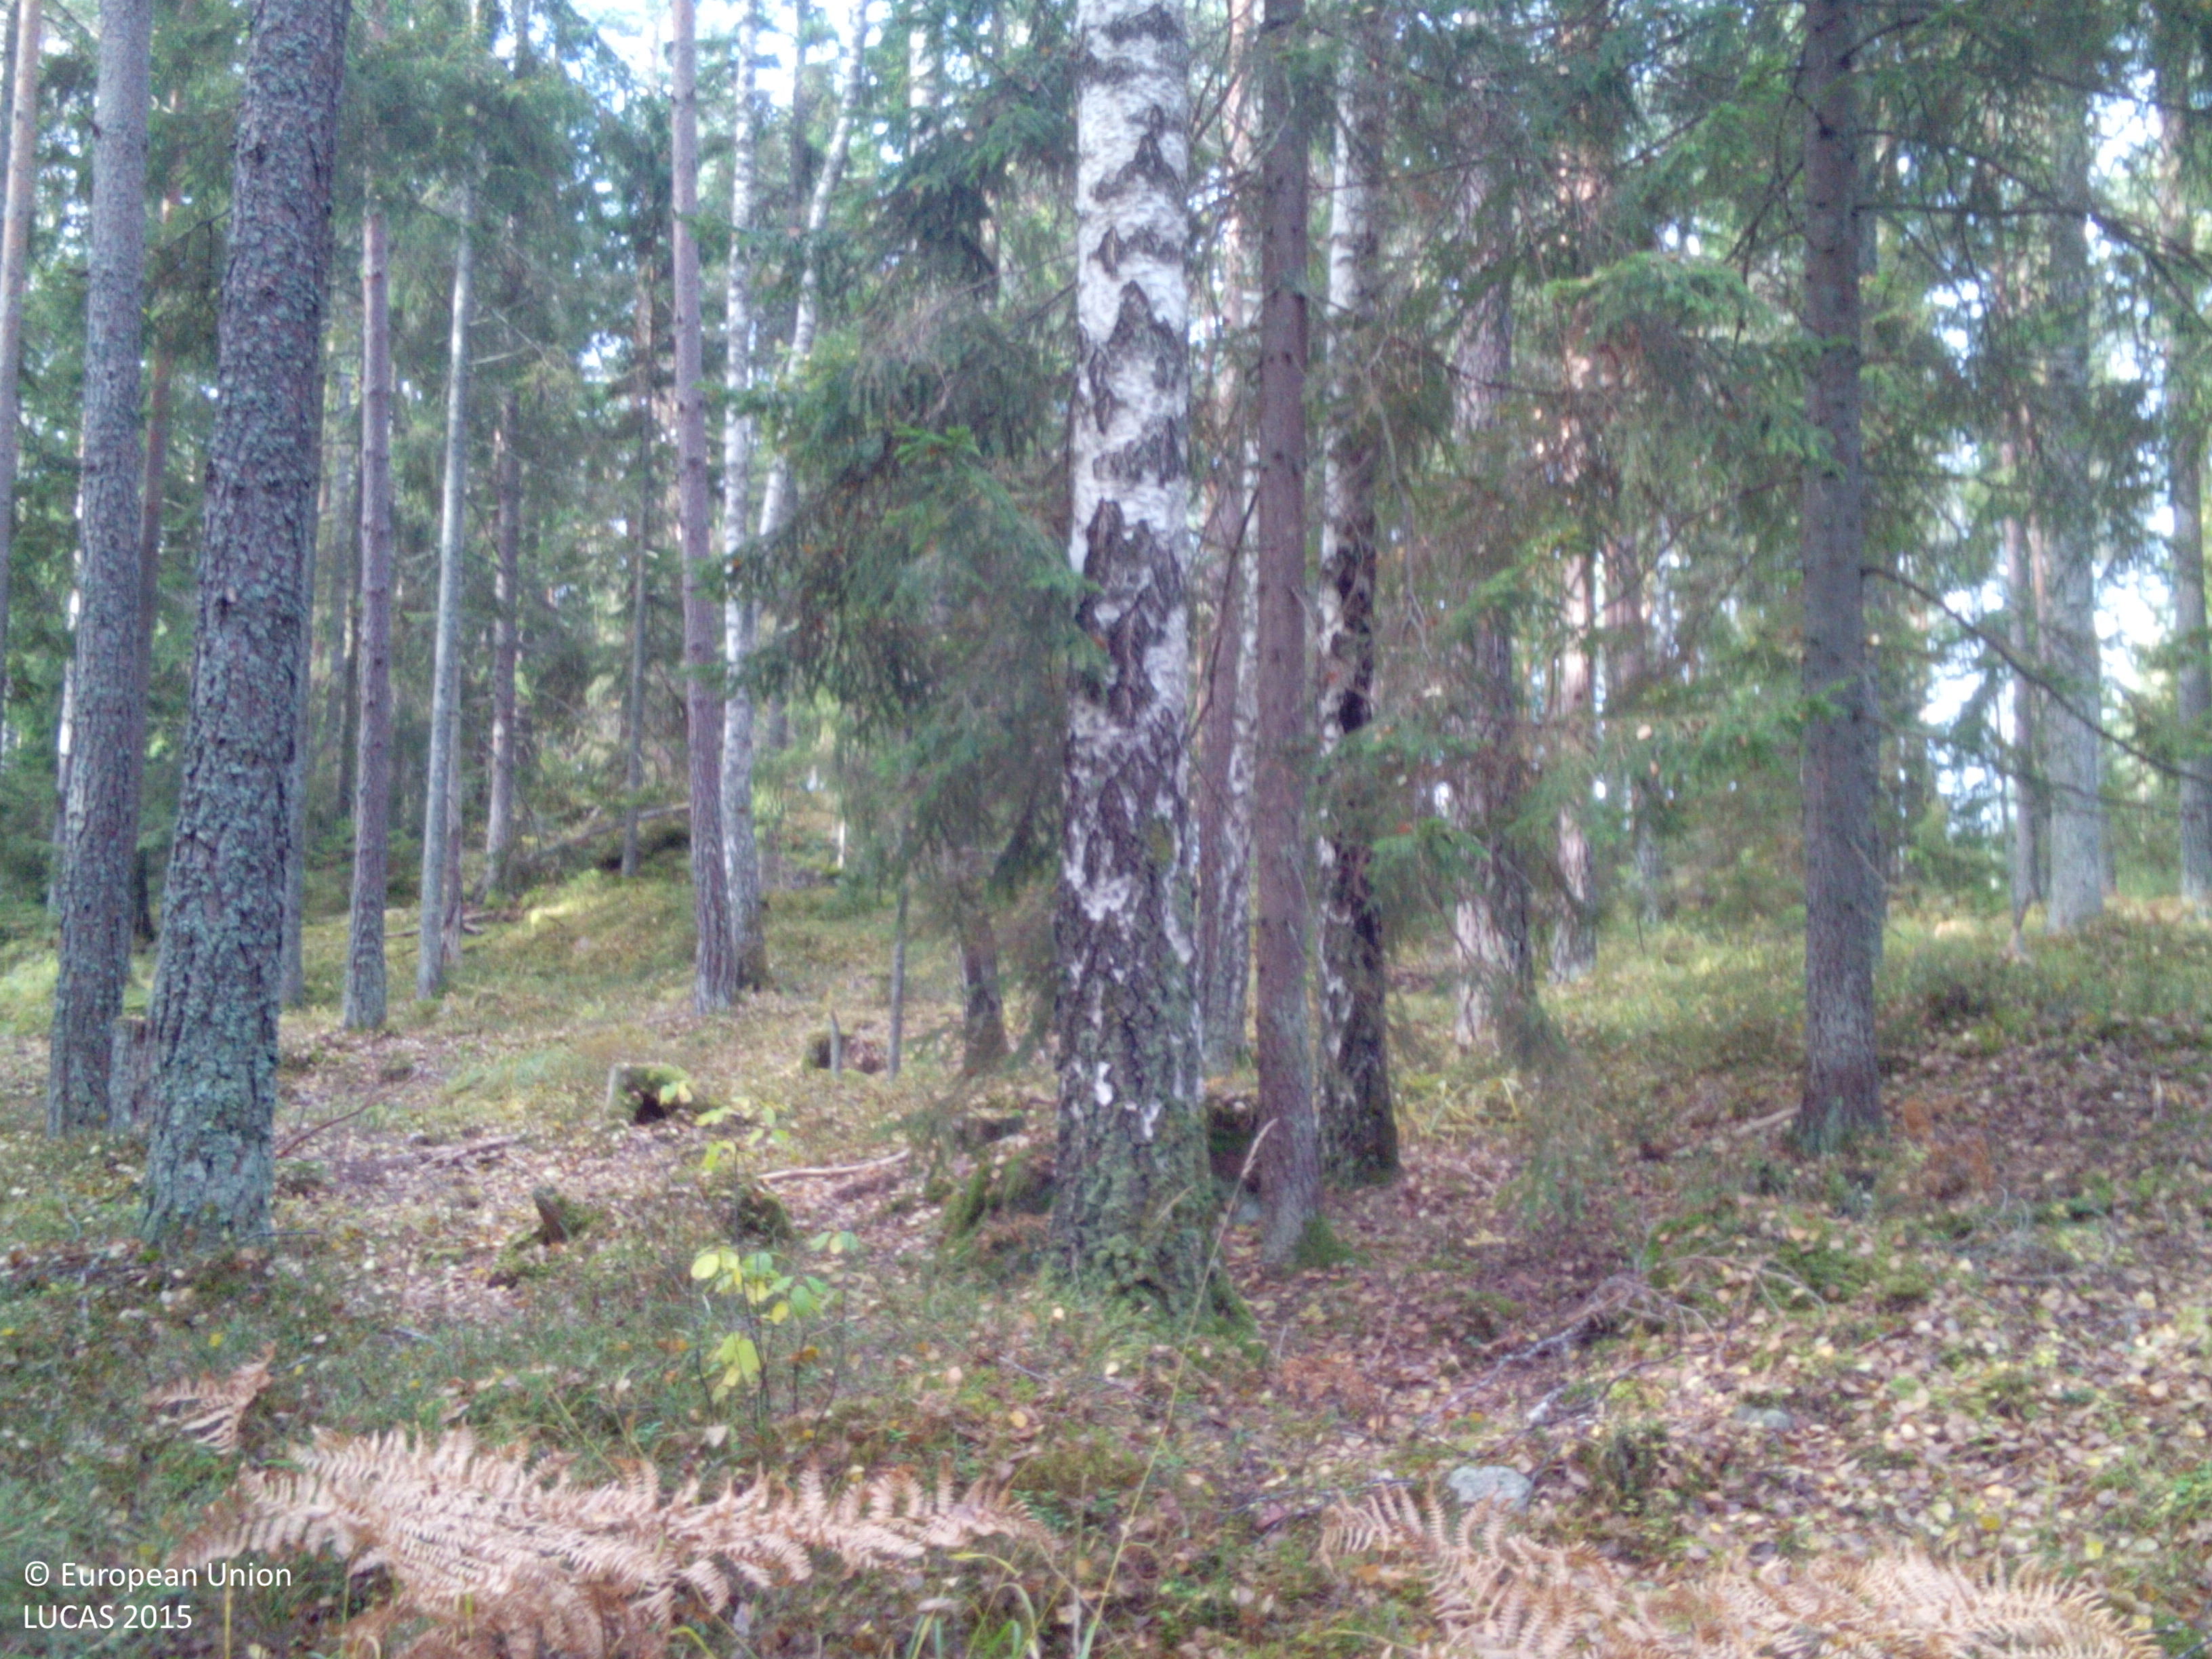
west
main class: Woodland
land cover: Other mixed woodland
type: boreal forest
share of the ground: > 75 %
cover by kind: coniferous forest trees 45 %, broadleaved forest trees 40 %, herbaceous plants 10 %, lichens and mosses 5 %
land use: Forestry
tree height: > 5 m
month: October
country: SE
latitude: 59.2231
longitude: 16.3885
